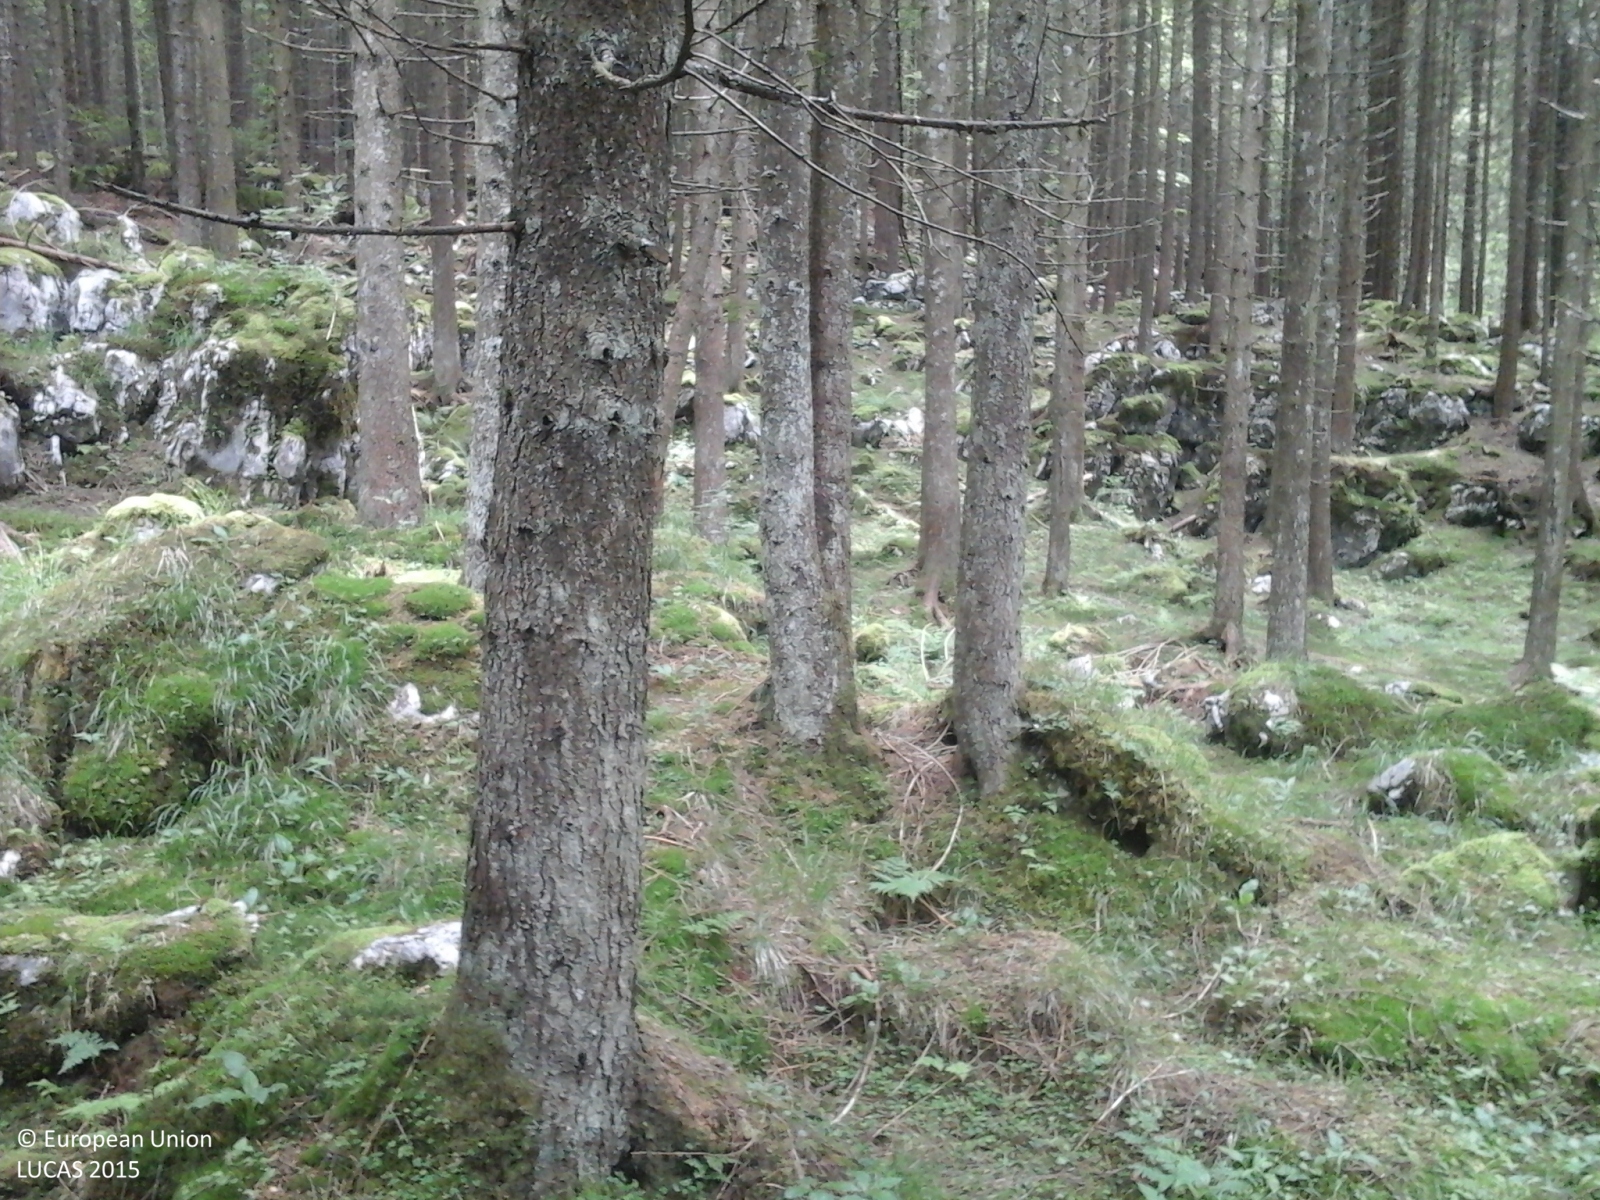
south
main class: Woodland
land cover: Spruce dominated mixed woodland
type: alpine coniferous forest
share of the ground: > 75 %
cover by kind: coniferous forest trees 75 %, broadleaved forest trees 25 %
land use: Forestry
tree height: > 5 m
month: June
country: IT
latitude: 45.8177
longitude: 11.5293
